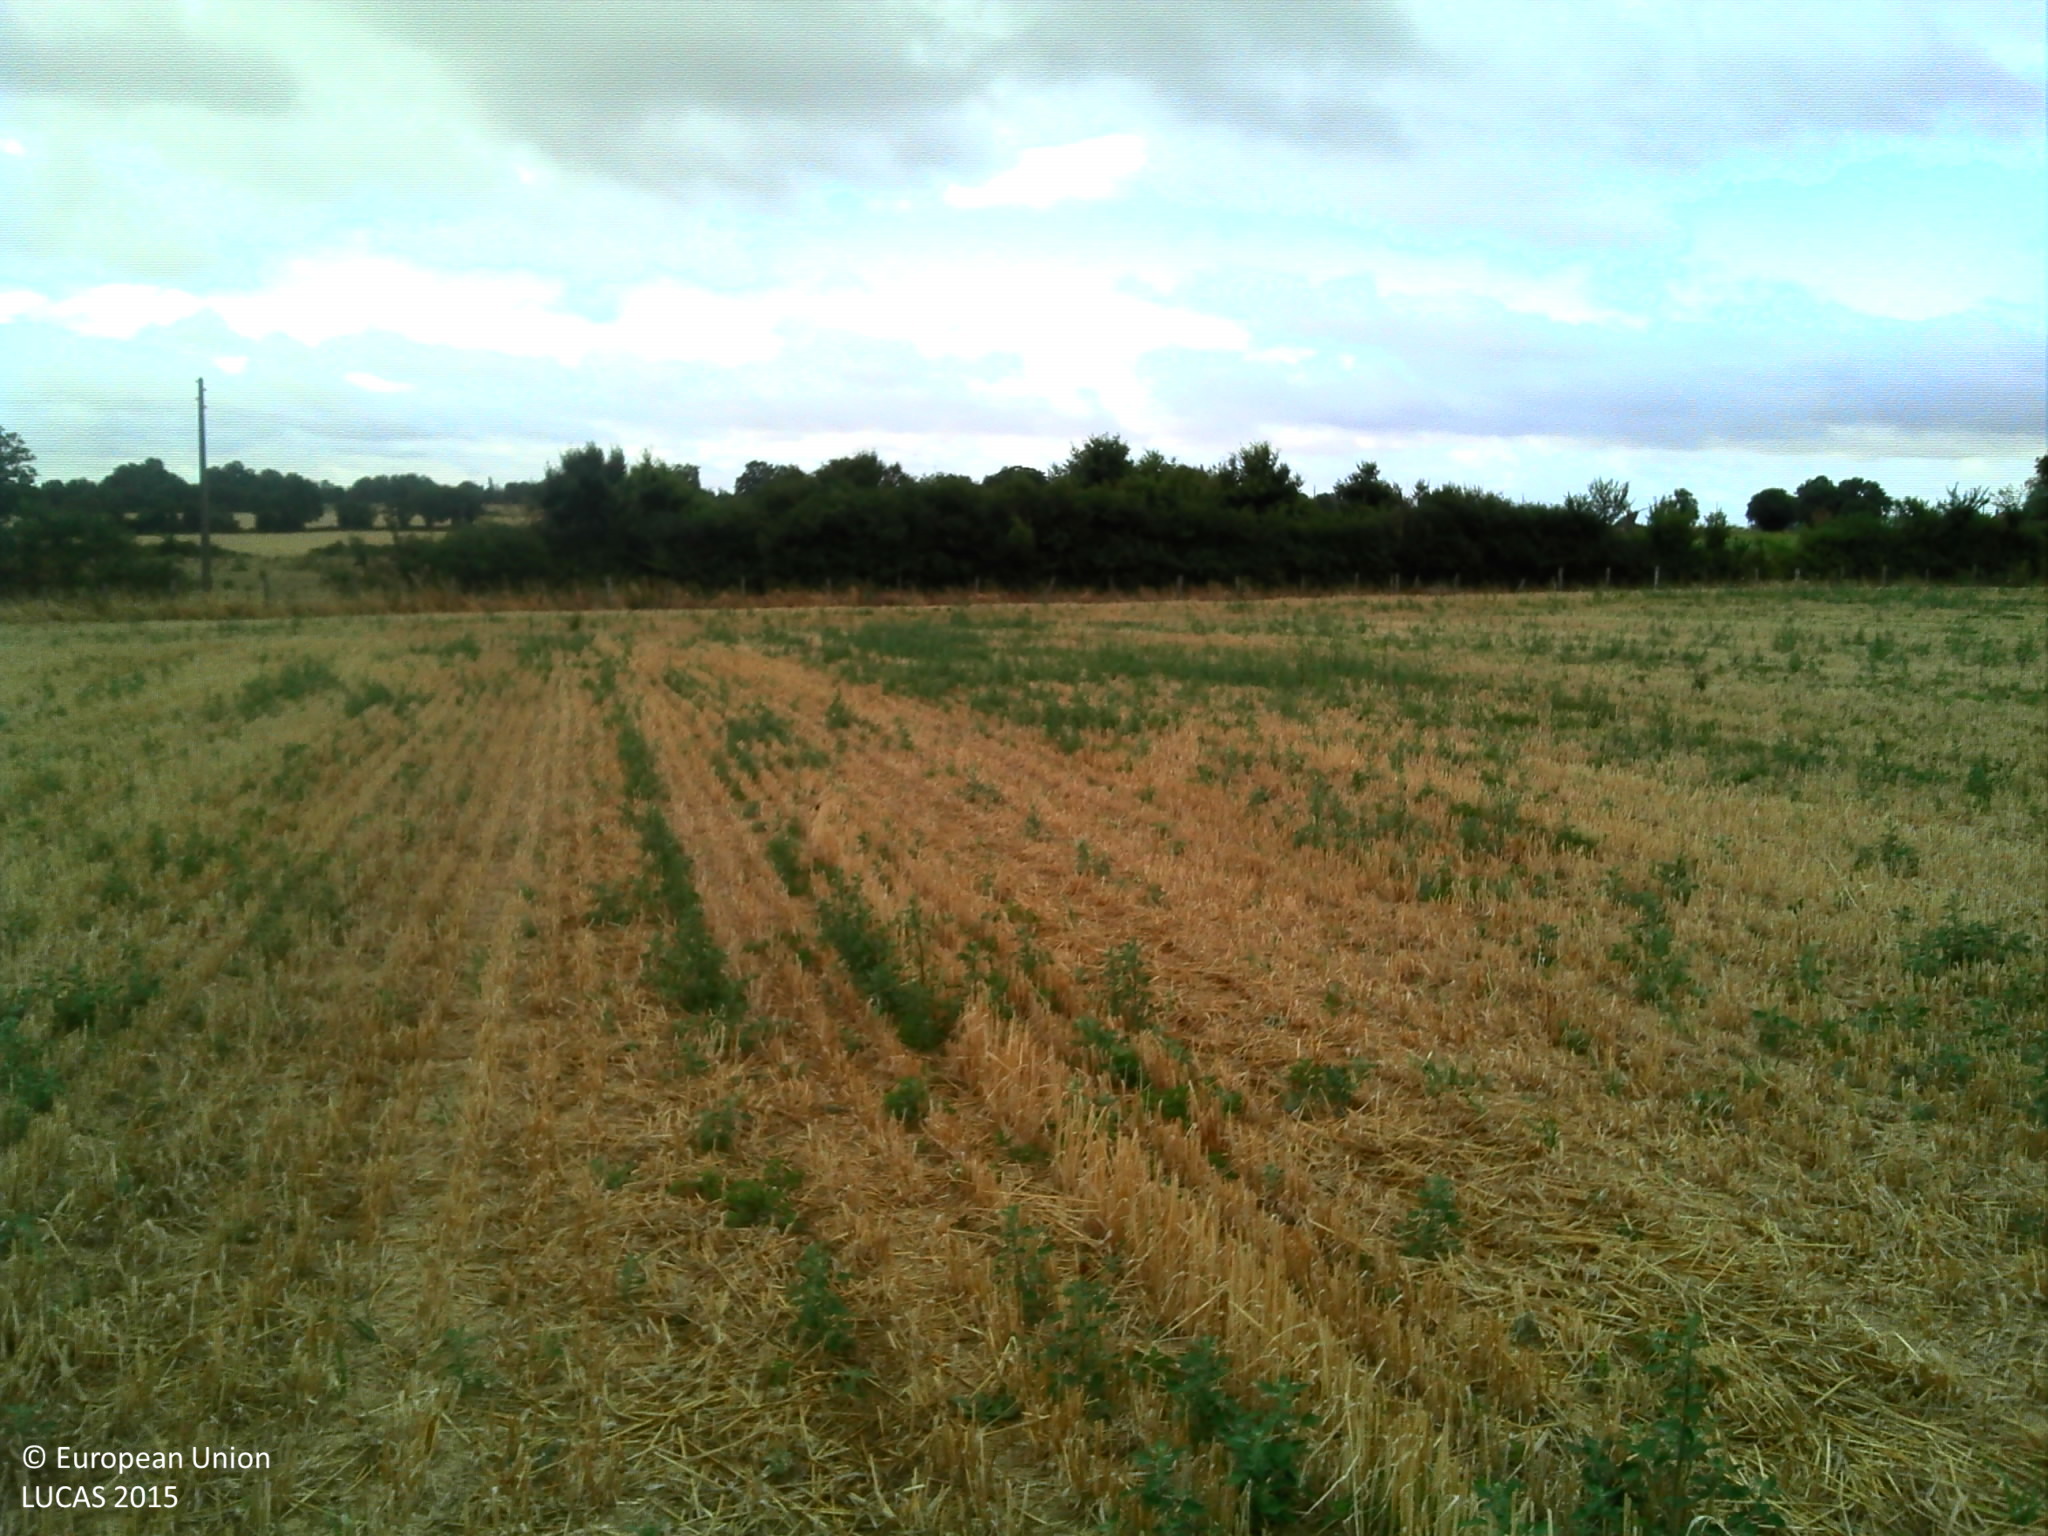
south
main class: Cropland
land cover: Barley
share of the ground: > 75 %
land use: Agriculture (excluding fallow land and kitchen gardens)
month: July
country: FR
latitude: 46.7236
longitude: 2.2869
